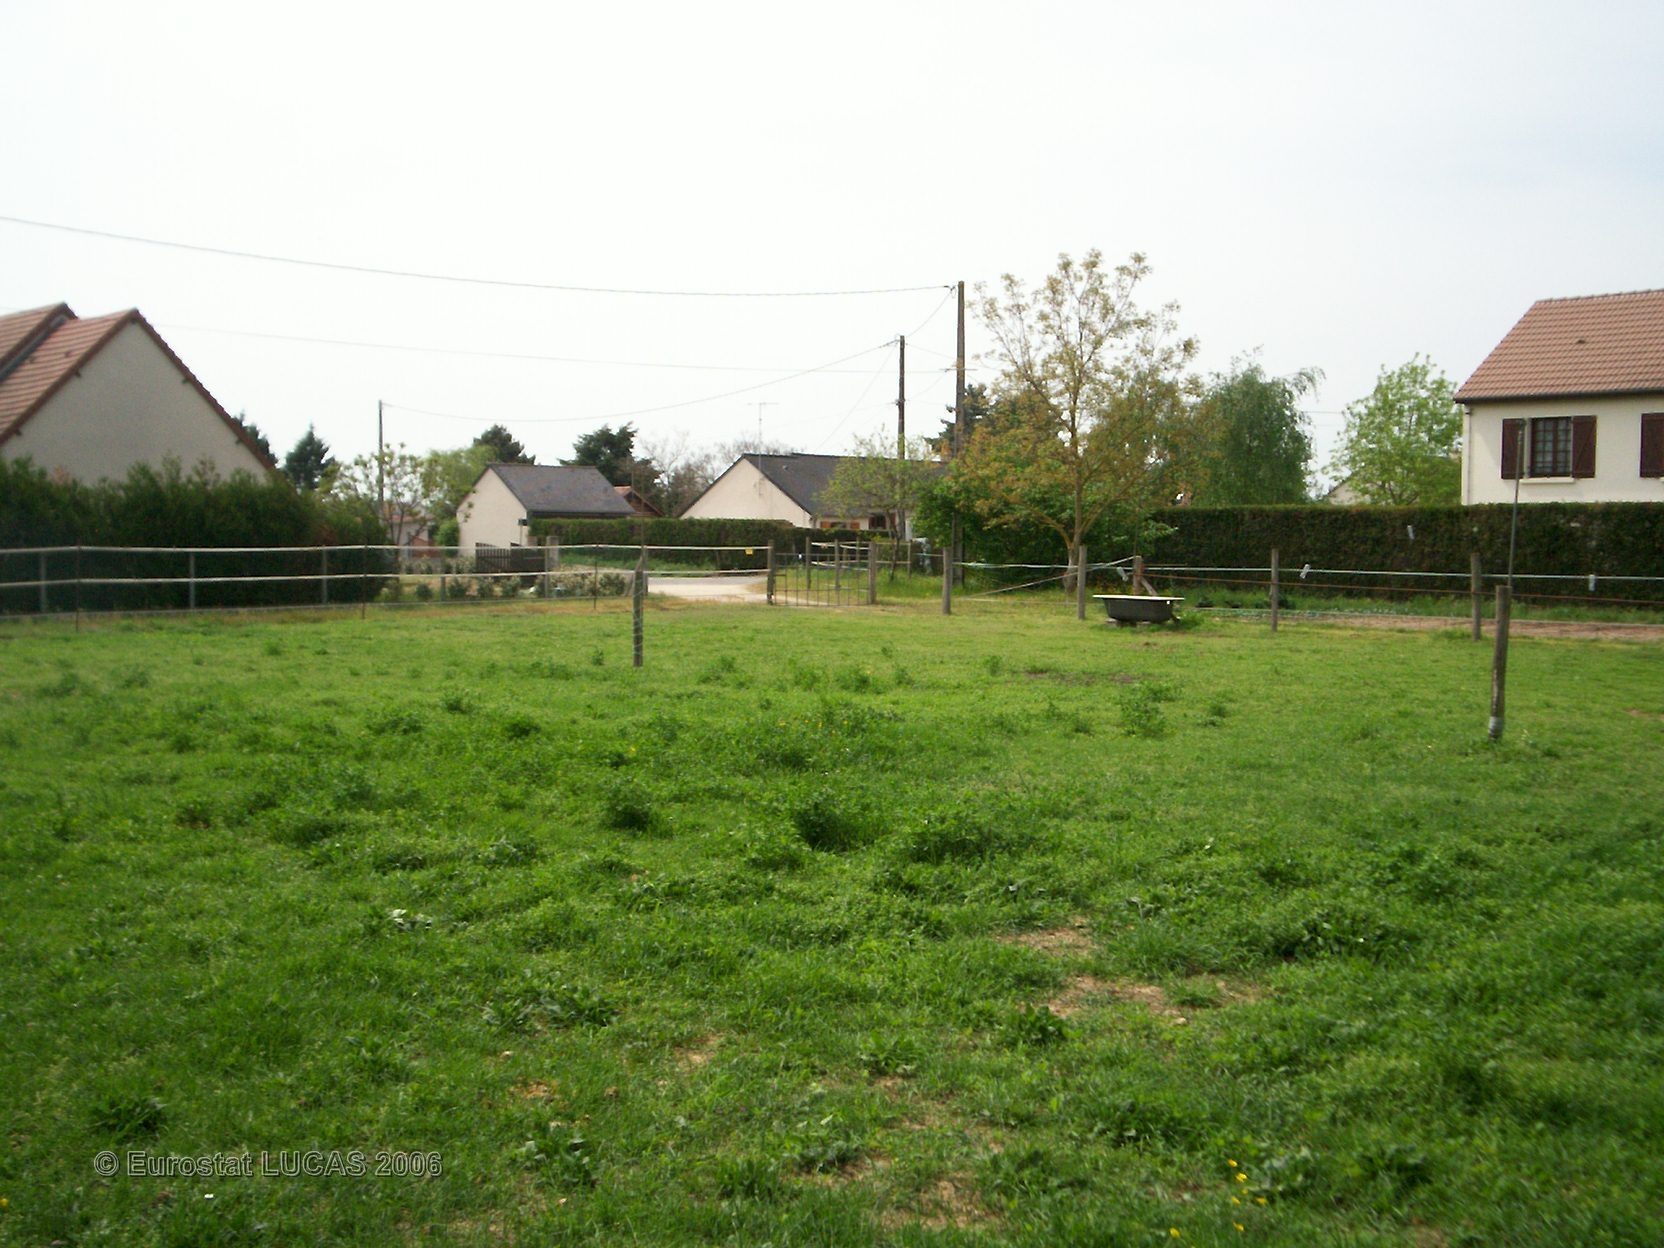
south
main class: Grassland
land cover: Grassland without tree/shrub cover
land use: Agriculture (excluding fallow land and kitchen gardens)
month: May
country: FR
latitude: 47.3156
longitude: 0.4139
